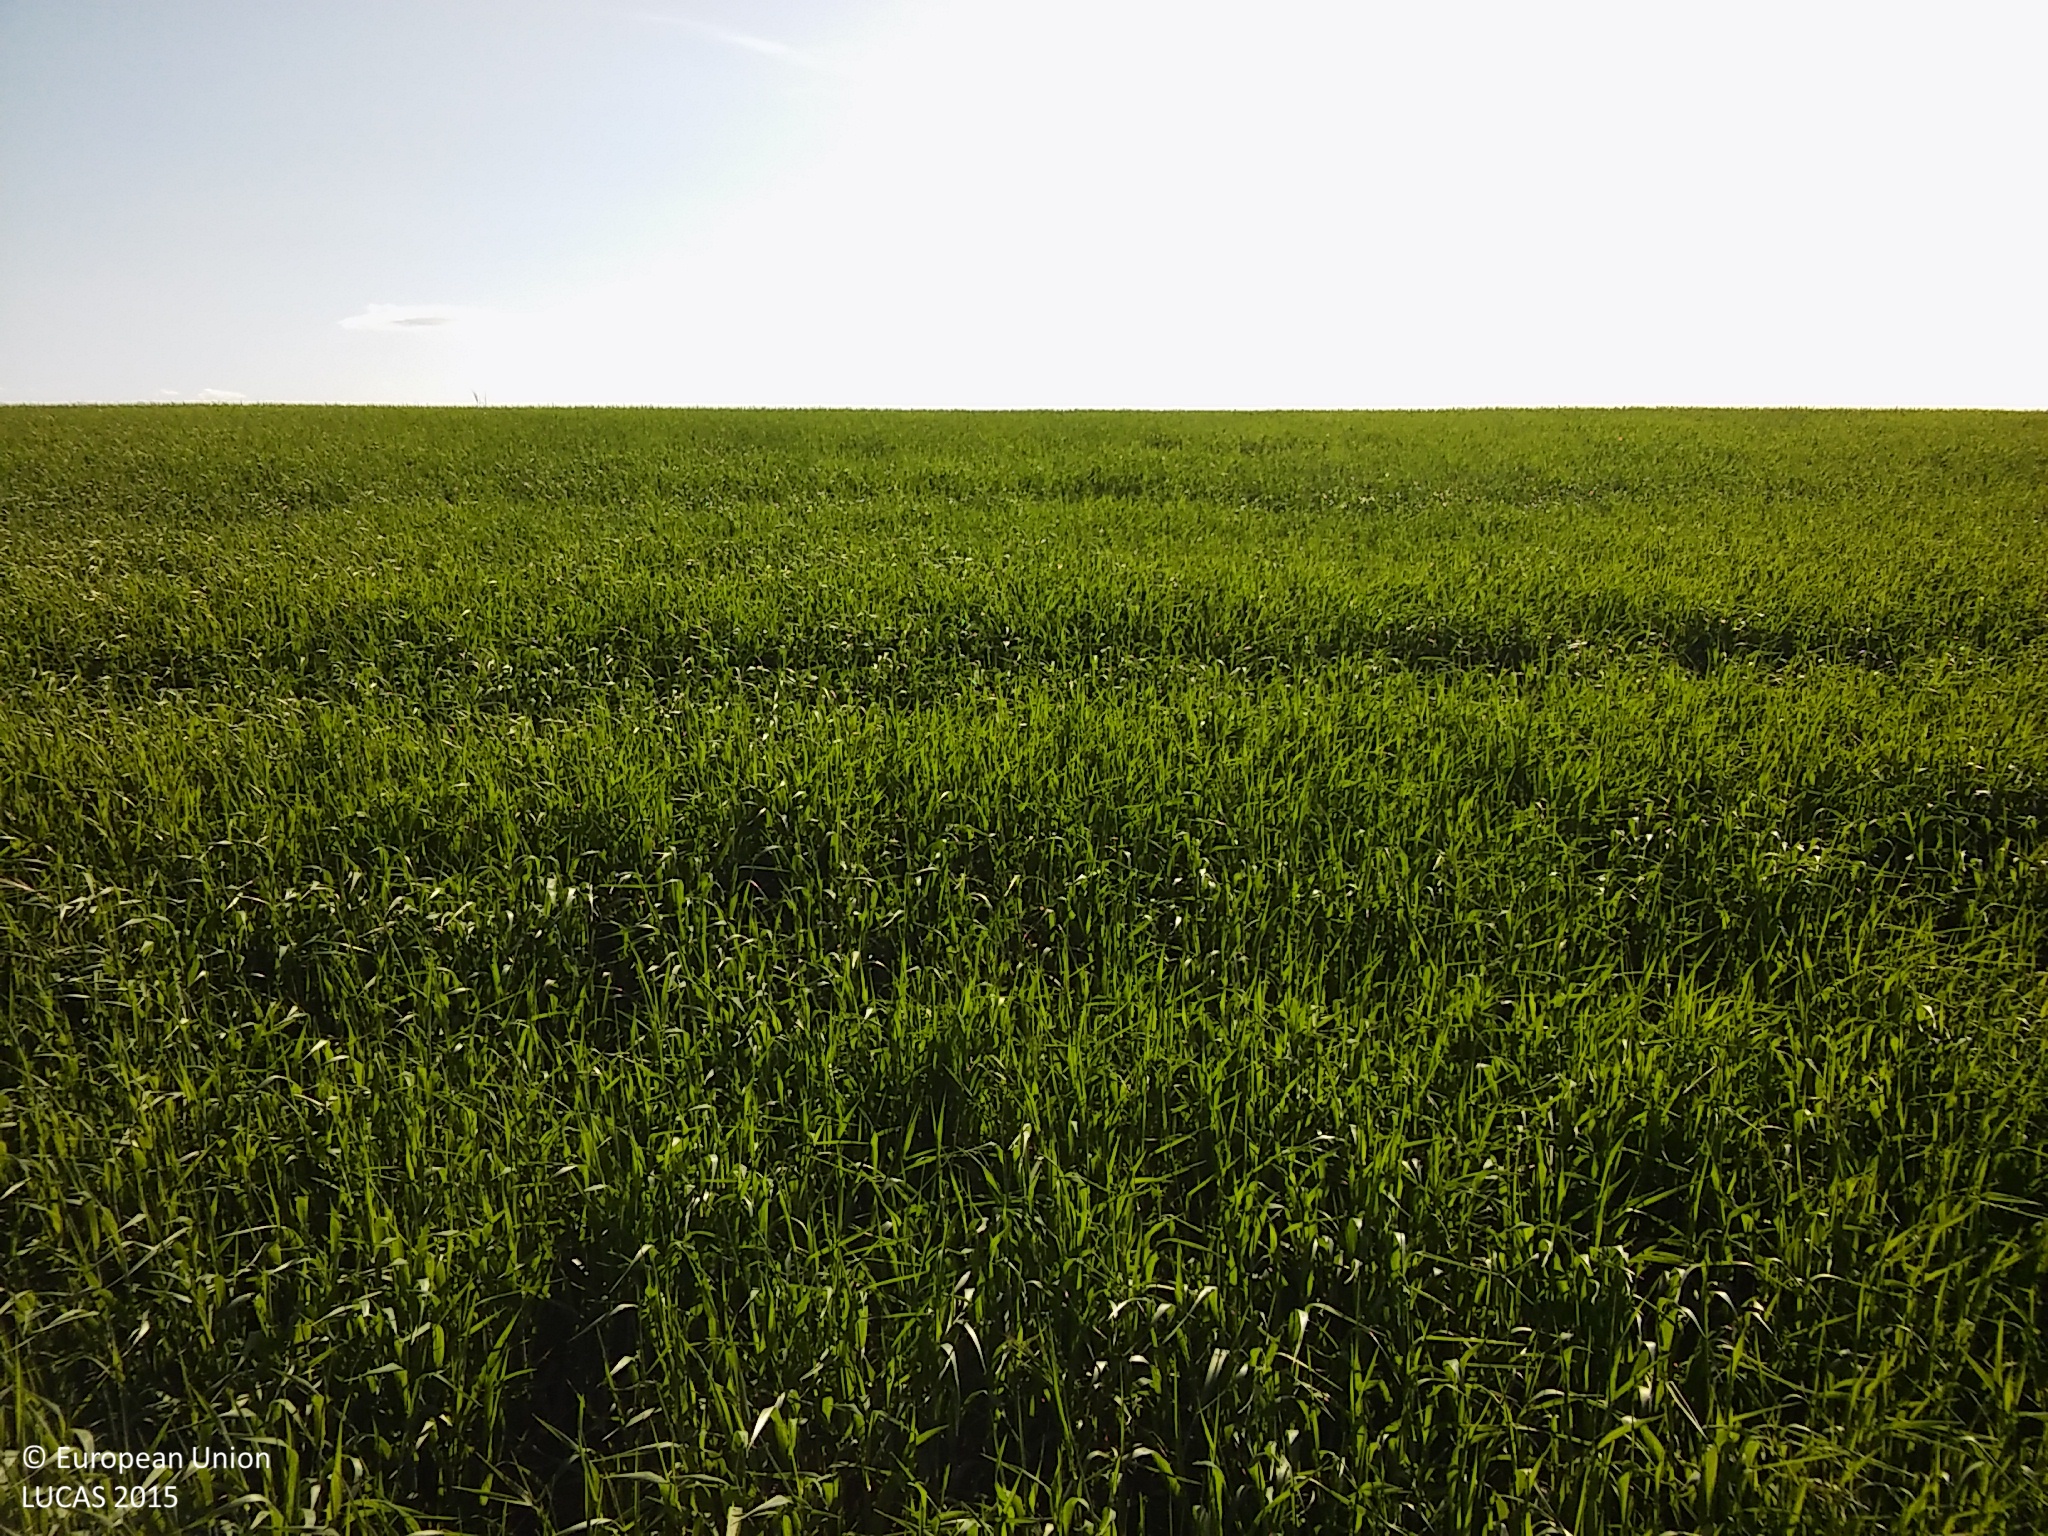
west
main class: Cropland
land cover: Barley
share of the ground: > 75 %
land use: Agriculture (excluding fallow land and kitchen gardens)
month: May
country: ES
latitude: 41.4641
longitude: -4.0763
